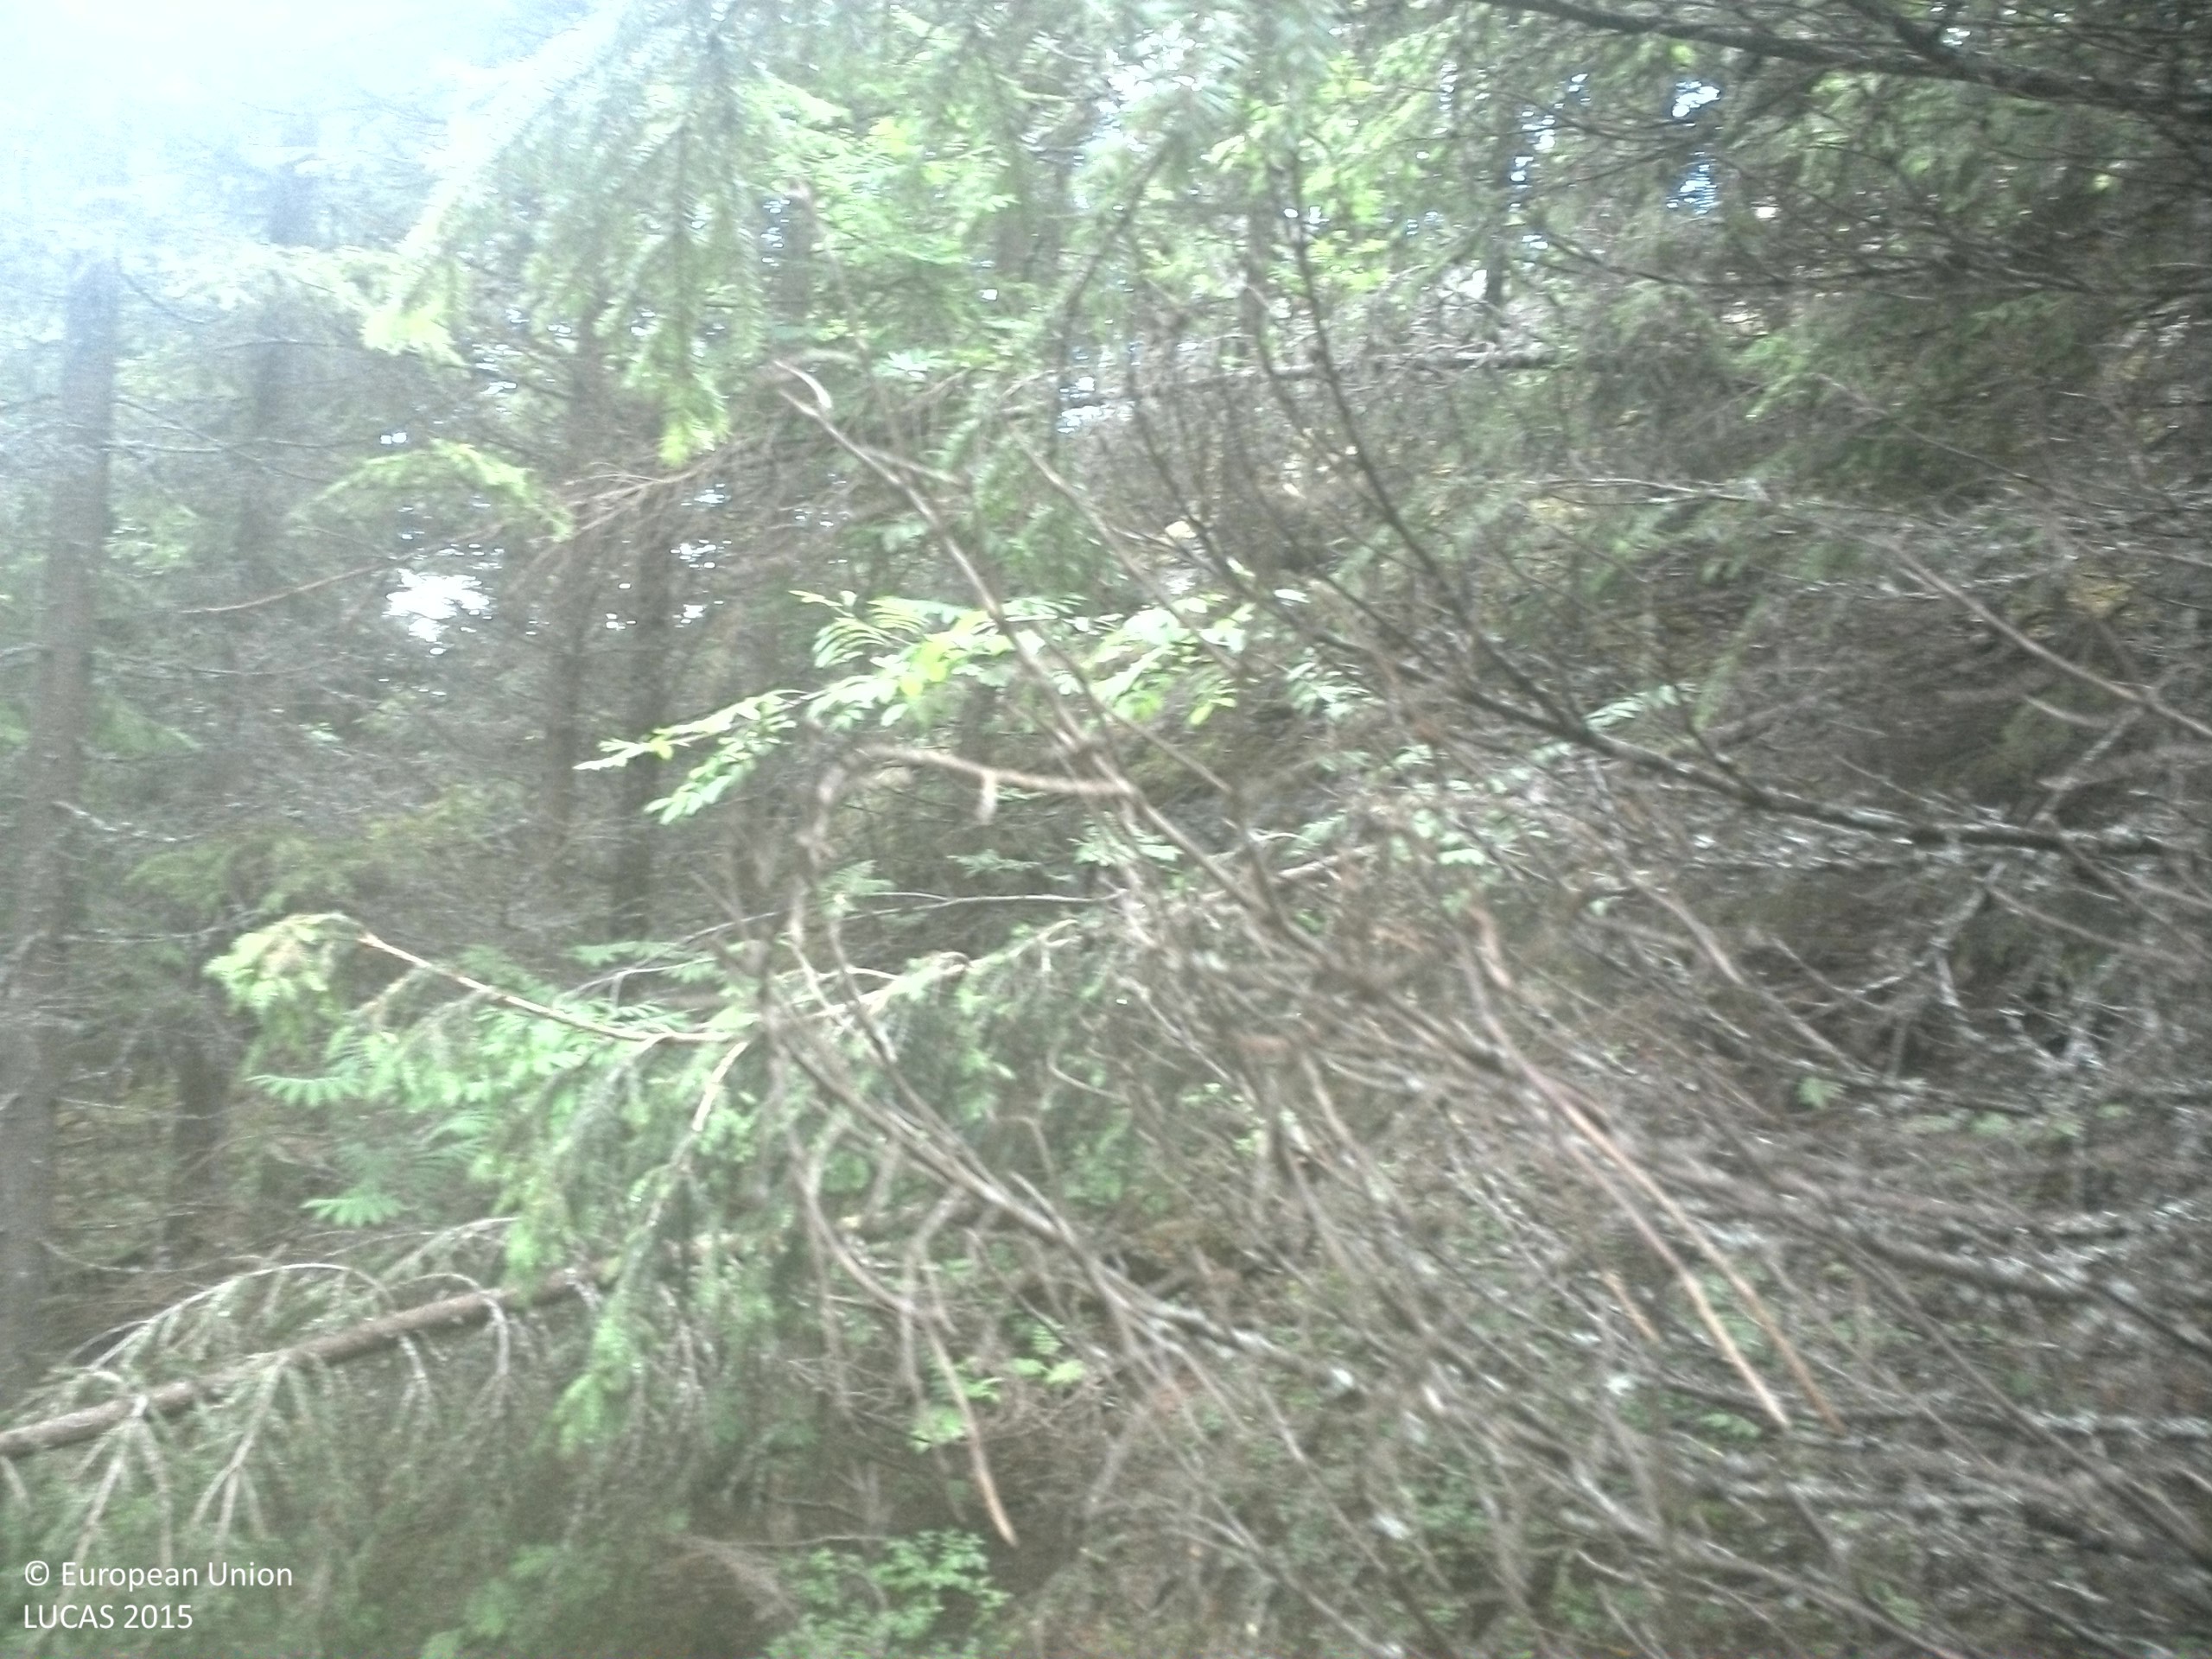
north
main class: Woodland
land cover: Spruce dominated coniferous woodland
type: boreal forest
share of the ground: > 75 %
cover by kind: coniferous forest trees 75 %, shrubs 15 %, broadleaved forest trees 10 %
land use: Forestry
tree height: > 5 m
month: July
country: SE
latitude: 63.5842
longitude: 18.5785
